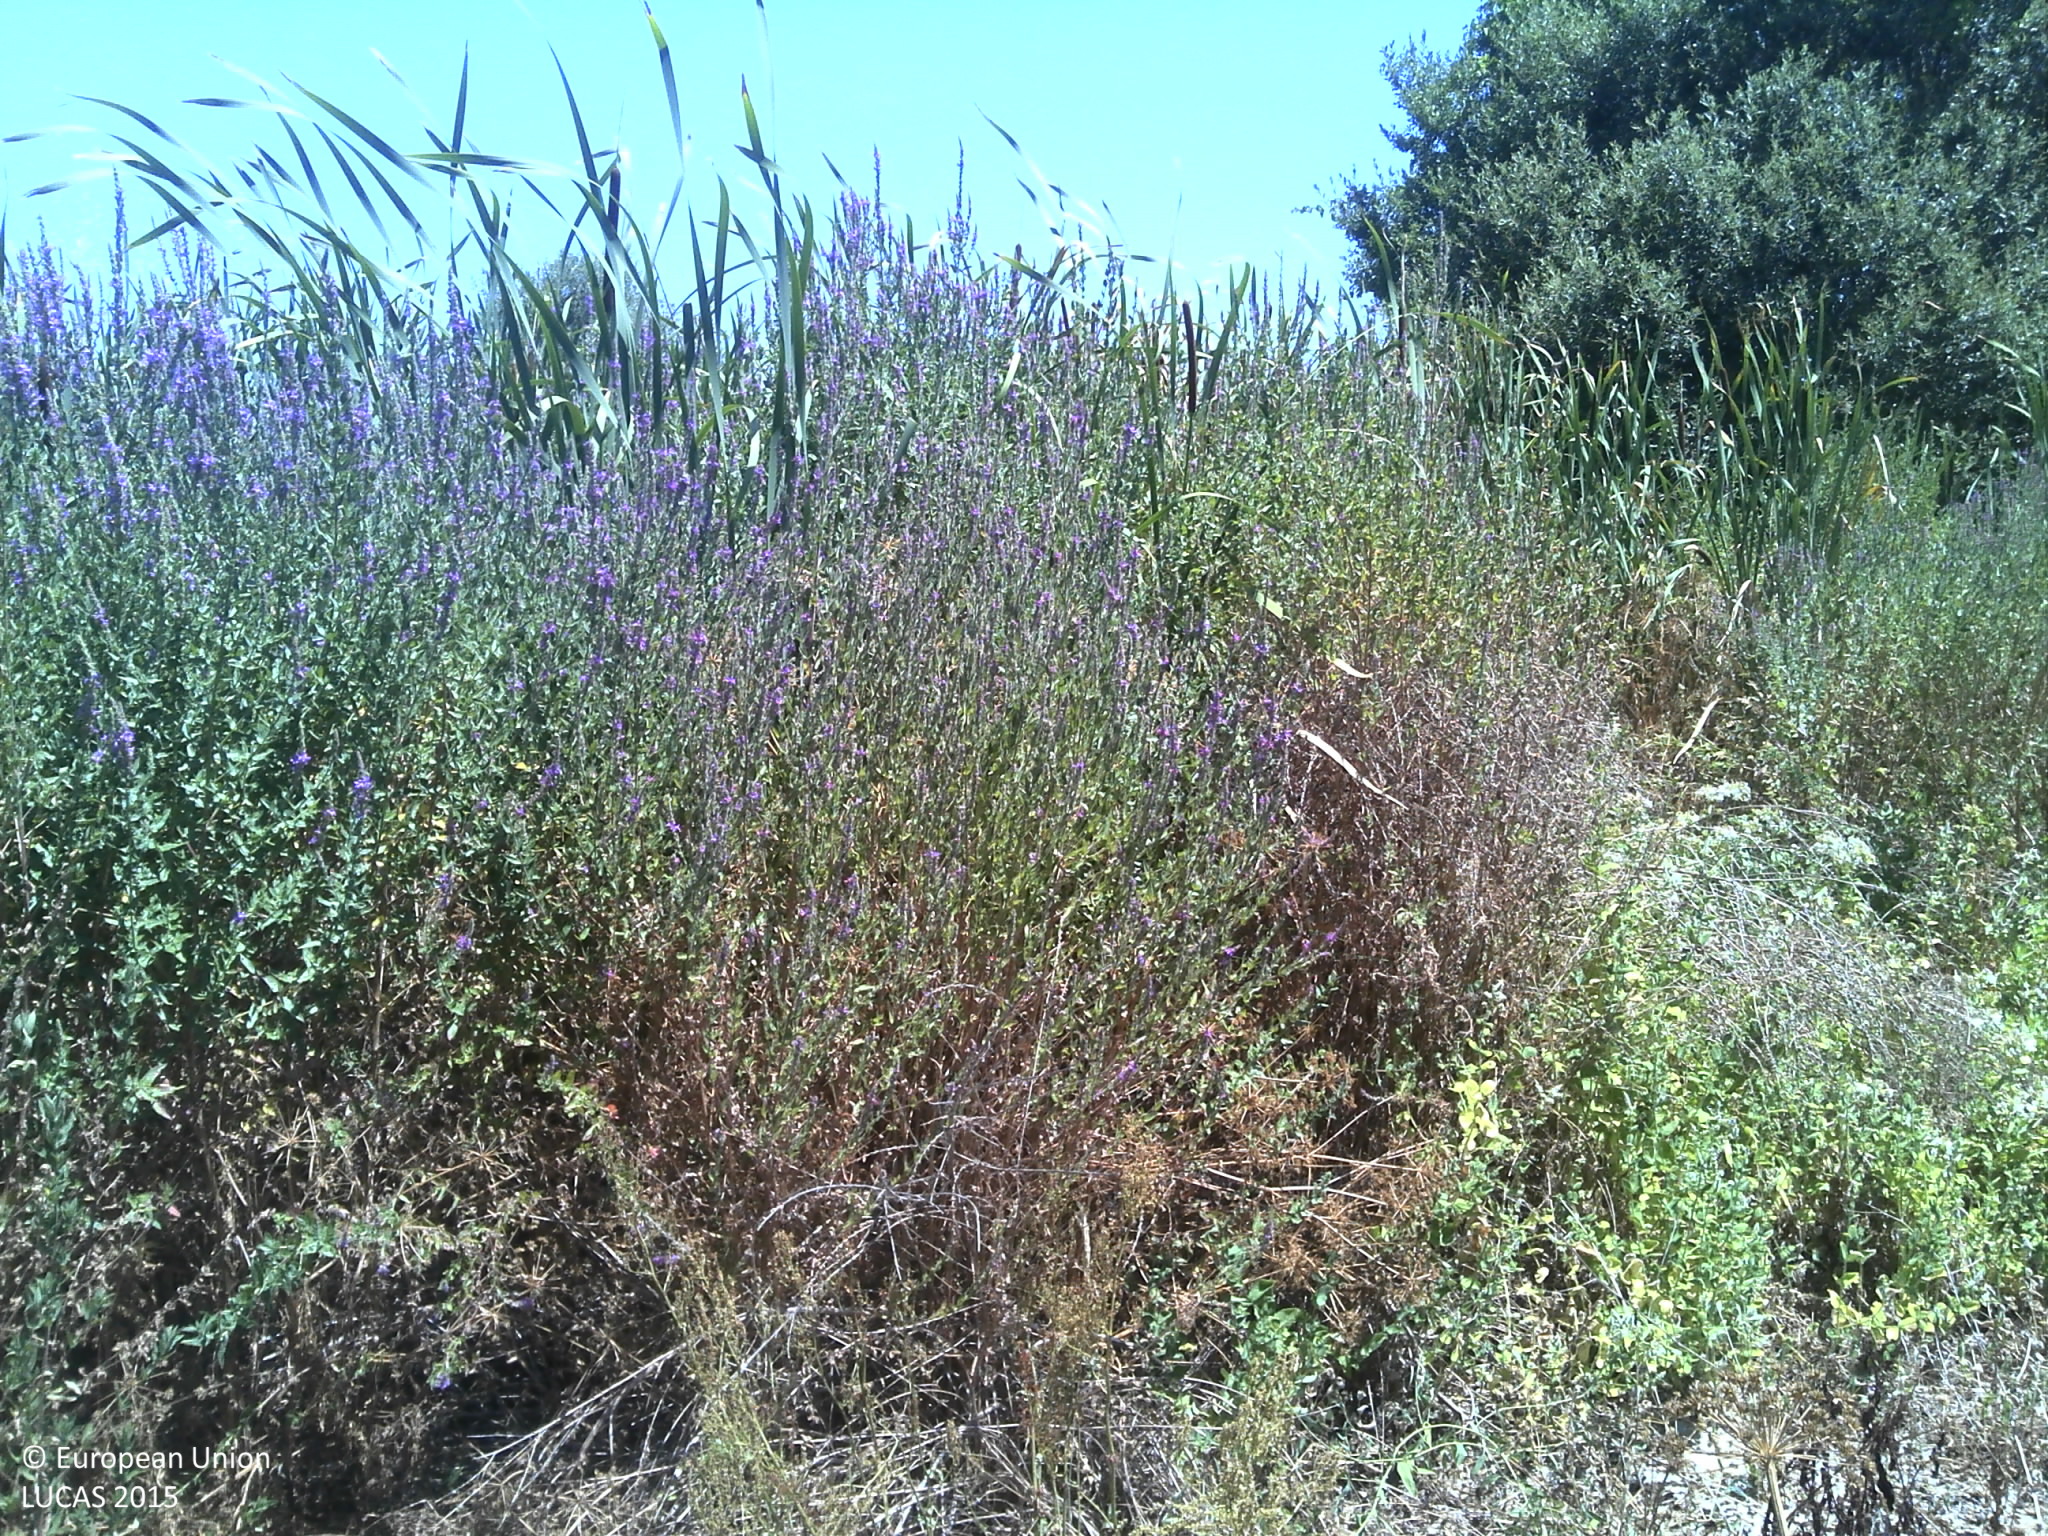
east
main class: Shrubland
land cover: Shrubland without tree cover
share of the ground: > 75 %
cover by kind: shrubs 80 %, herbaceous plants 10 %, unconsolidated bare surface 5 %
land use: Abandoned areas
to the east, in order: Shrubland without tree cover; Rivers and streams; Fences; Grassland without tree/shrub cover; Olive groves; Fences; Ditches and canals; Arable land (only in case pi); Abandoned hedges; Fences; Arable land (only in case pi); Abandoned hedges; Arable land (only in case pi); Tracks; Fences; Arable land (only in case pi); Artificial constructions in urban areas
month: July
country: PT
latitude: 40.4066
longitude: -7.3447
